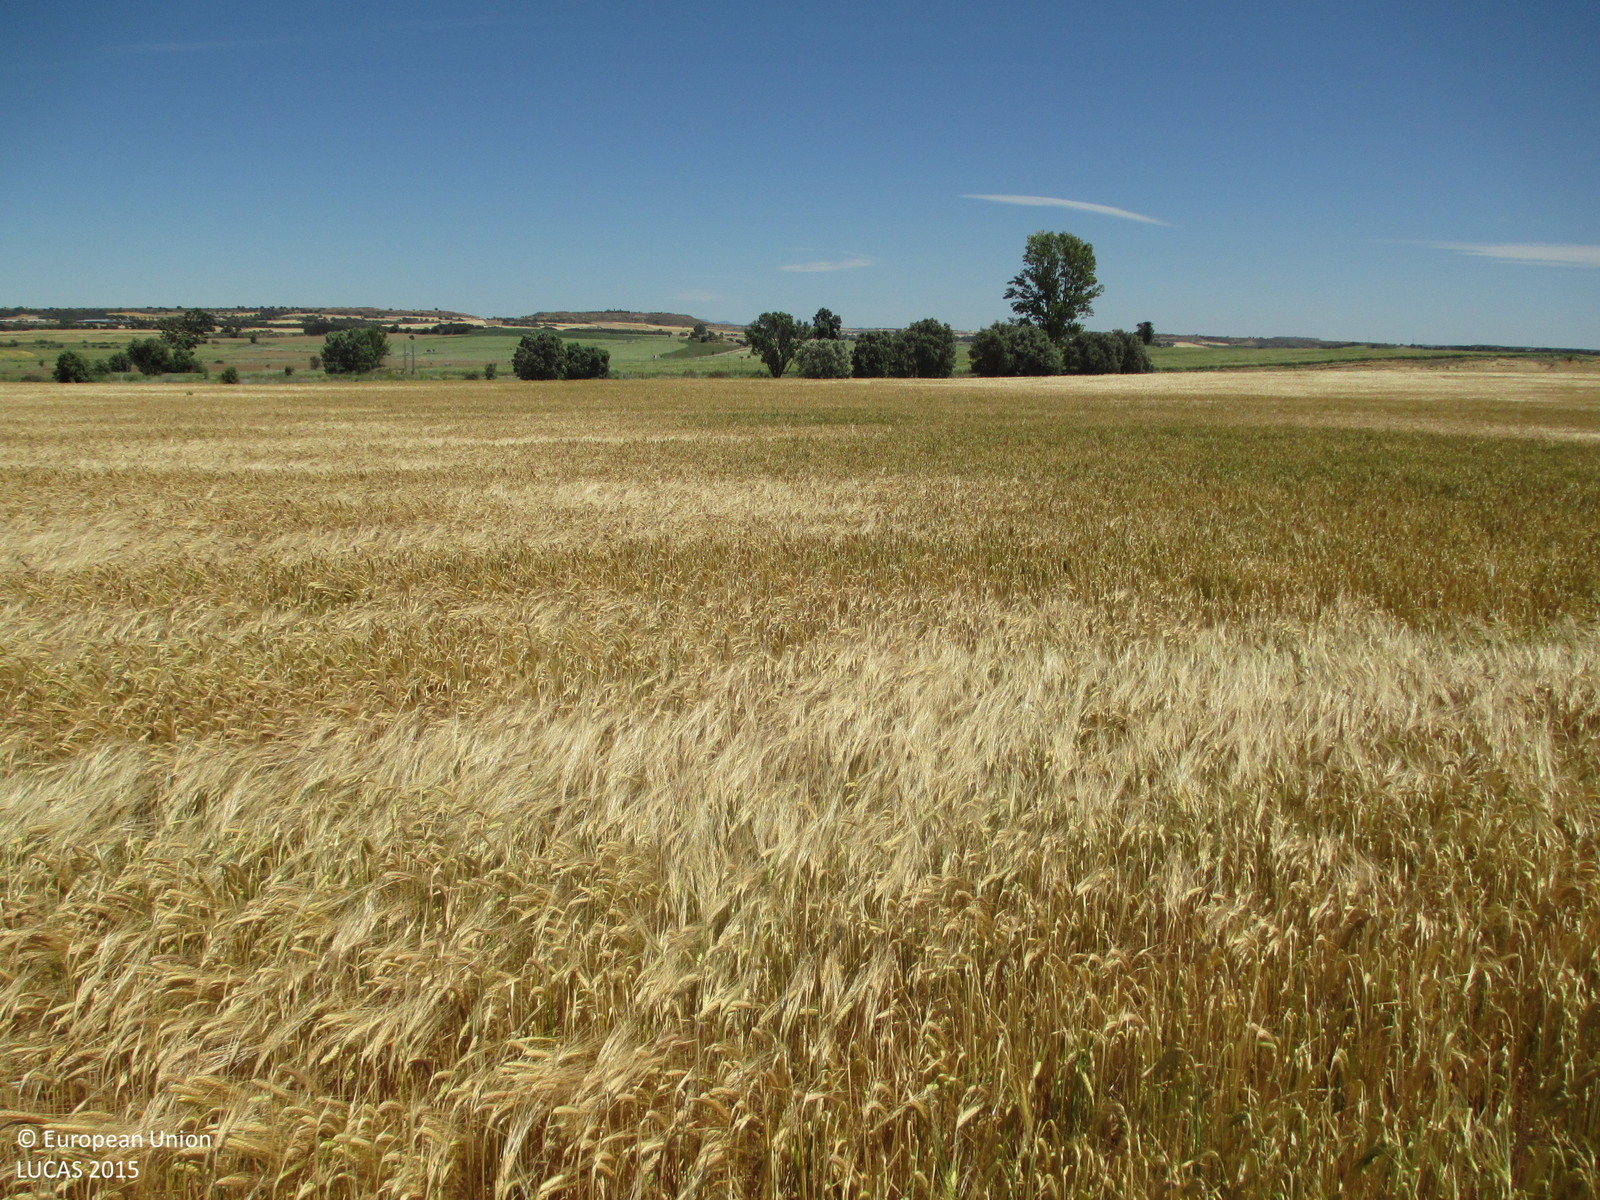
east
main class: Cropland
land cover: Barley
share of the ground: > 75 %
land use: Agriculture (excluding fallow land and kitchen gardens)
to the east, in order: Barley; Lines of trees; Spontaneously vegetated surfaces; Ditches and canals; Paved roads, cycling and walking lanes; Grass margins; Common wheat; Shruby margins; Lucerne
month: May
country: ES
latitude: 41.9951
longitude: -0.1722
